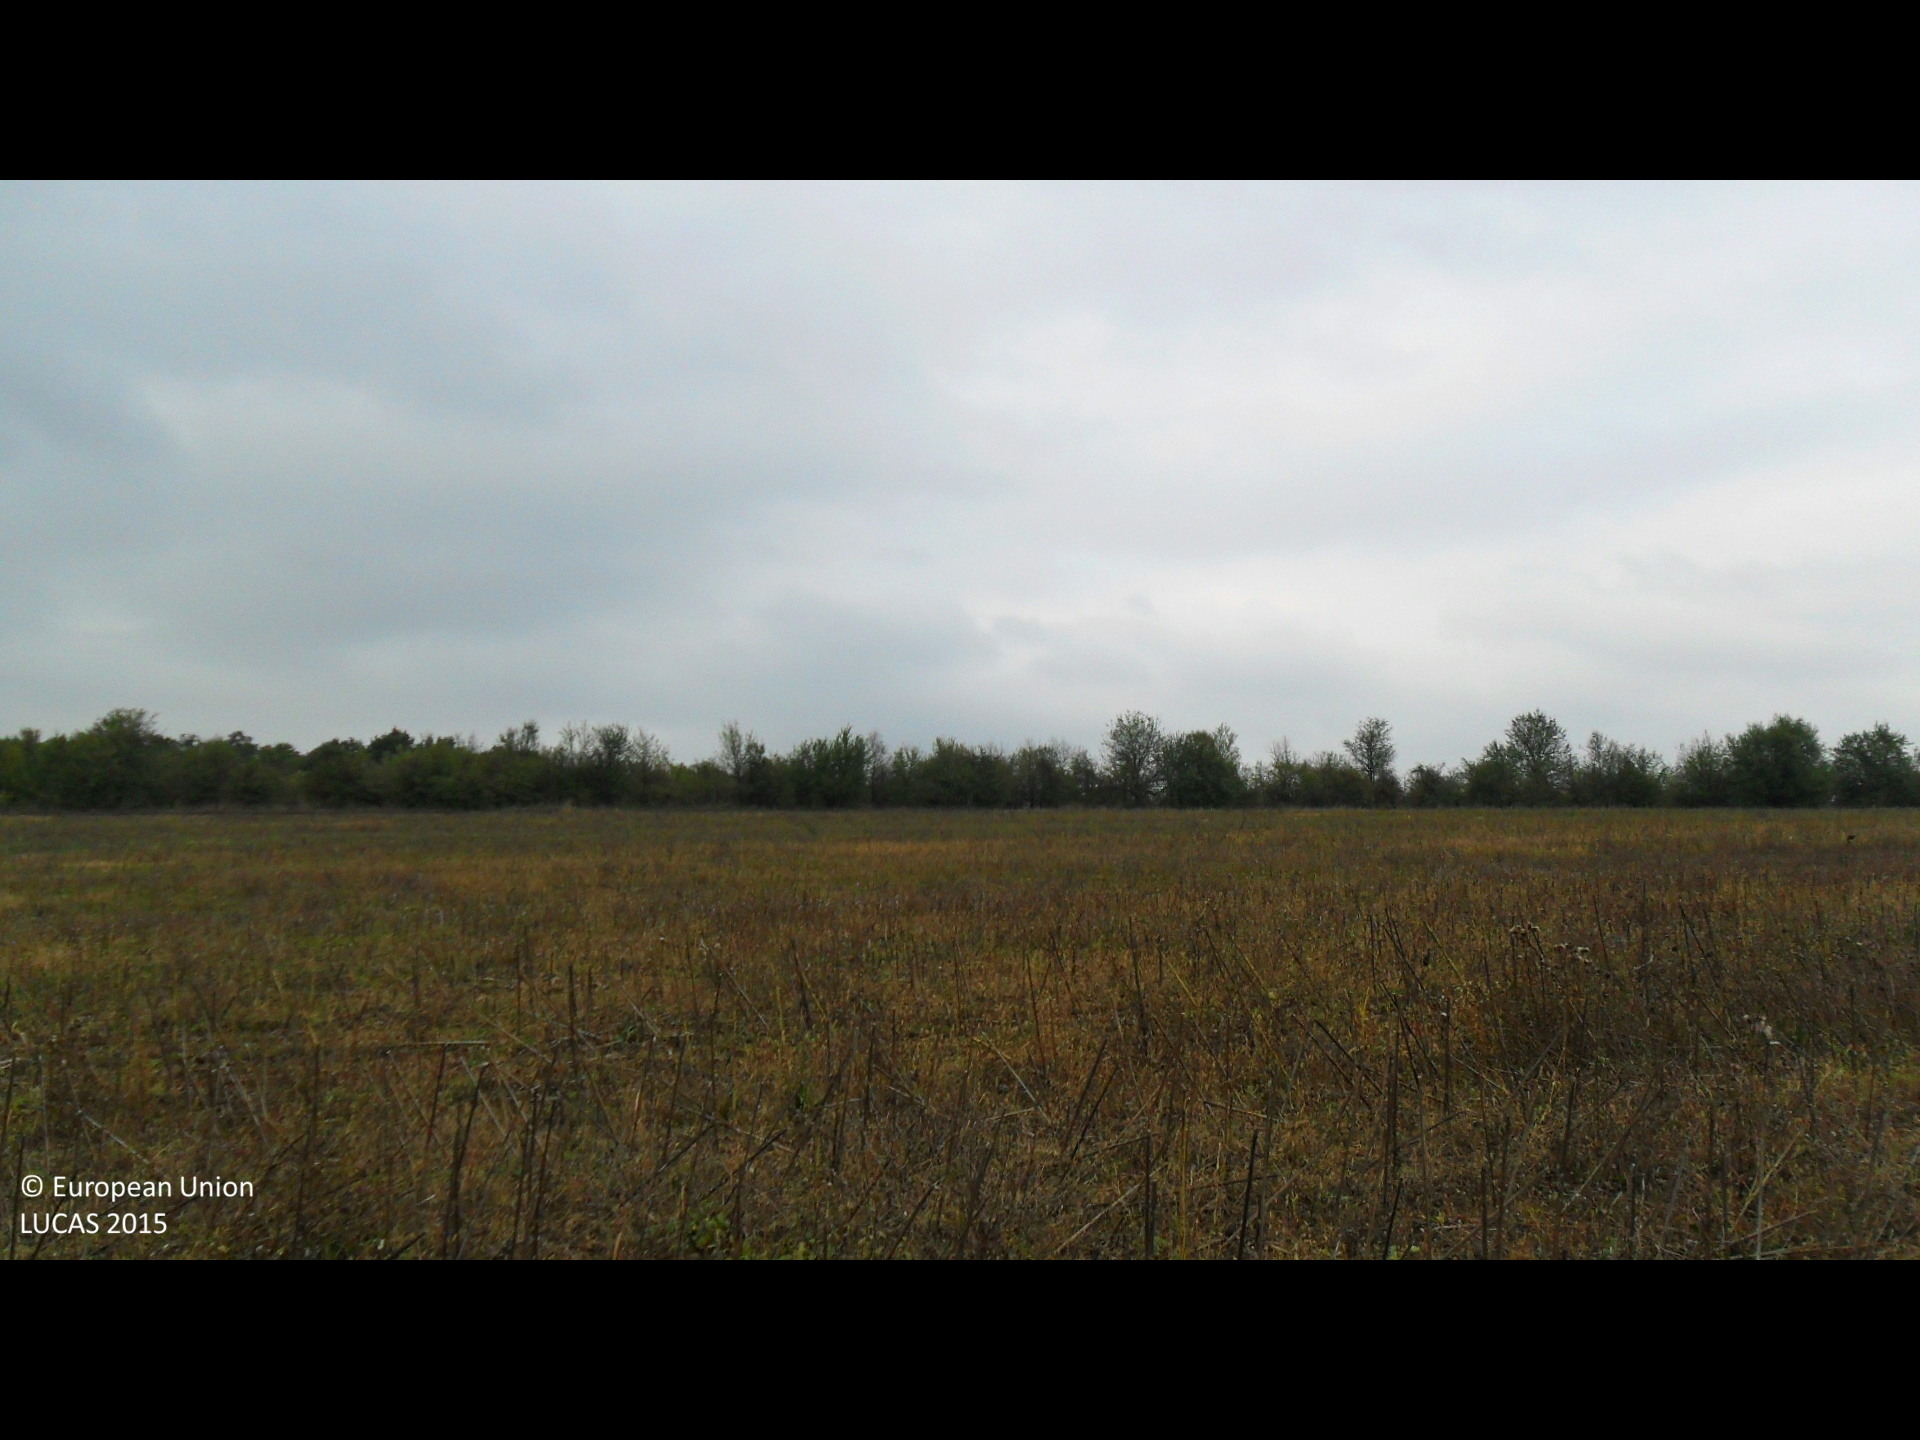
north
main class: Cropland
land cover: Sunflower
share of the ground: 10 - 25 %
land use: Agriculture (excluding fallow land and kitchen gardens)
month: September
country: BG
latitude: 43.1488
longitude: 26.2646
